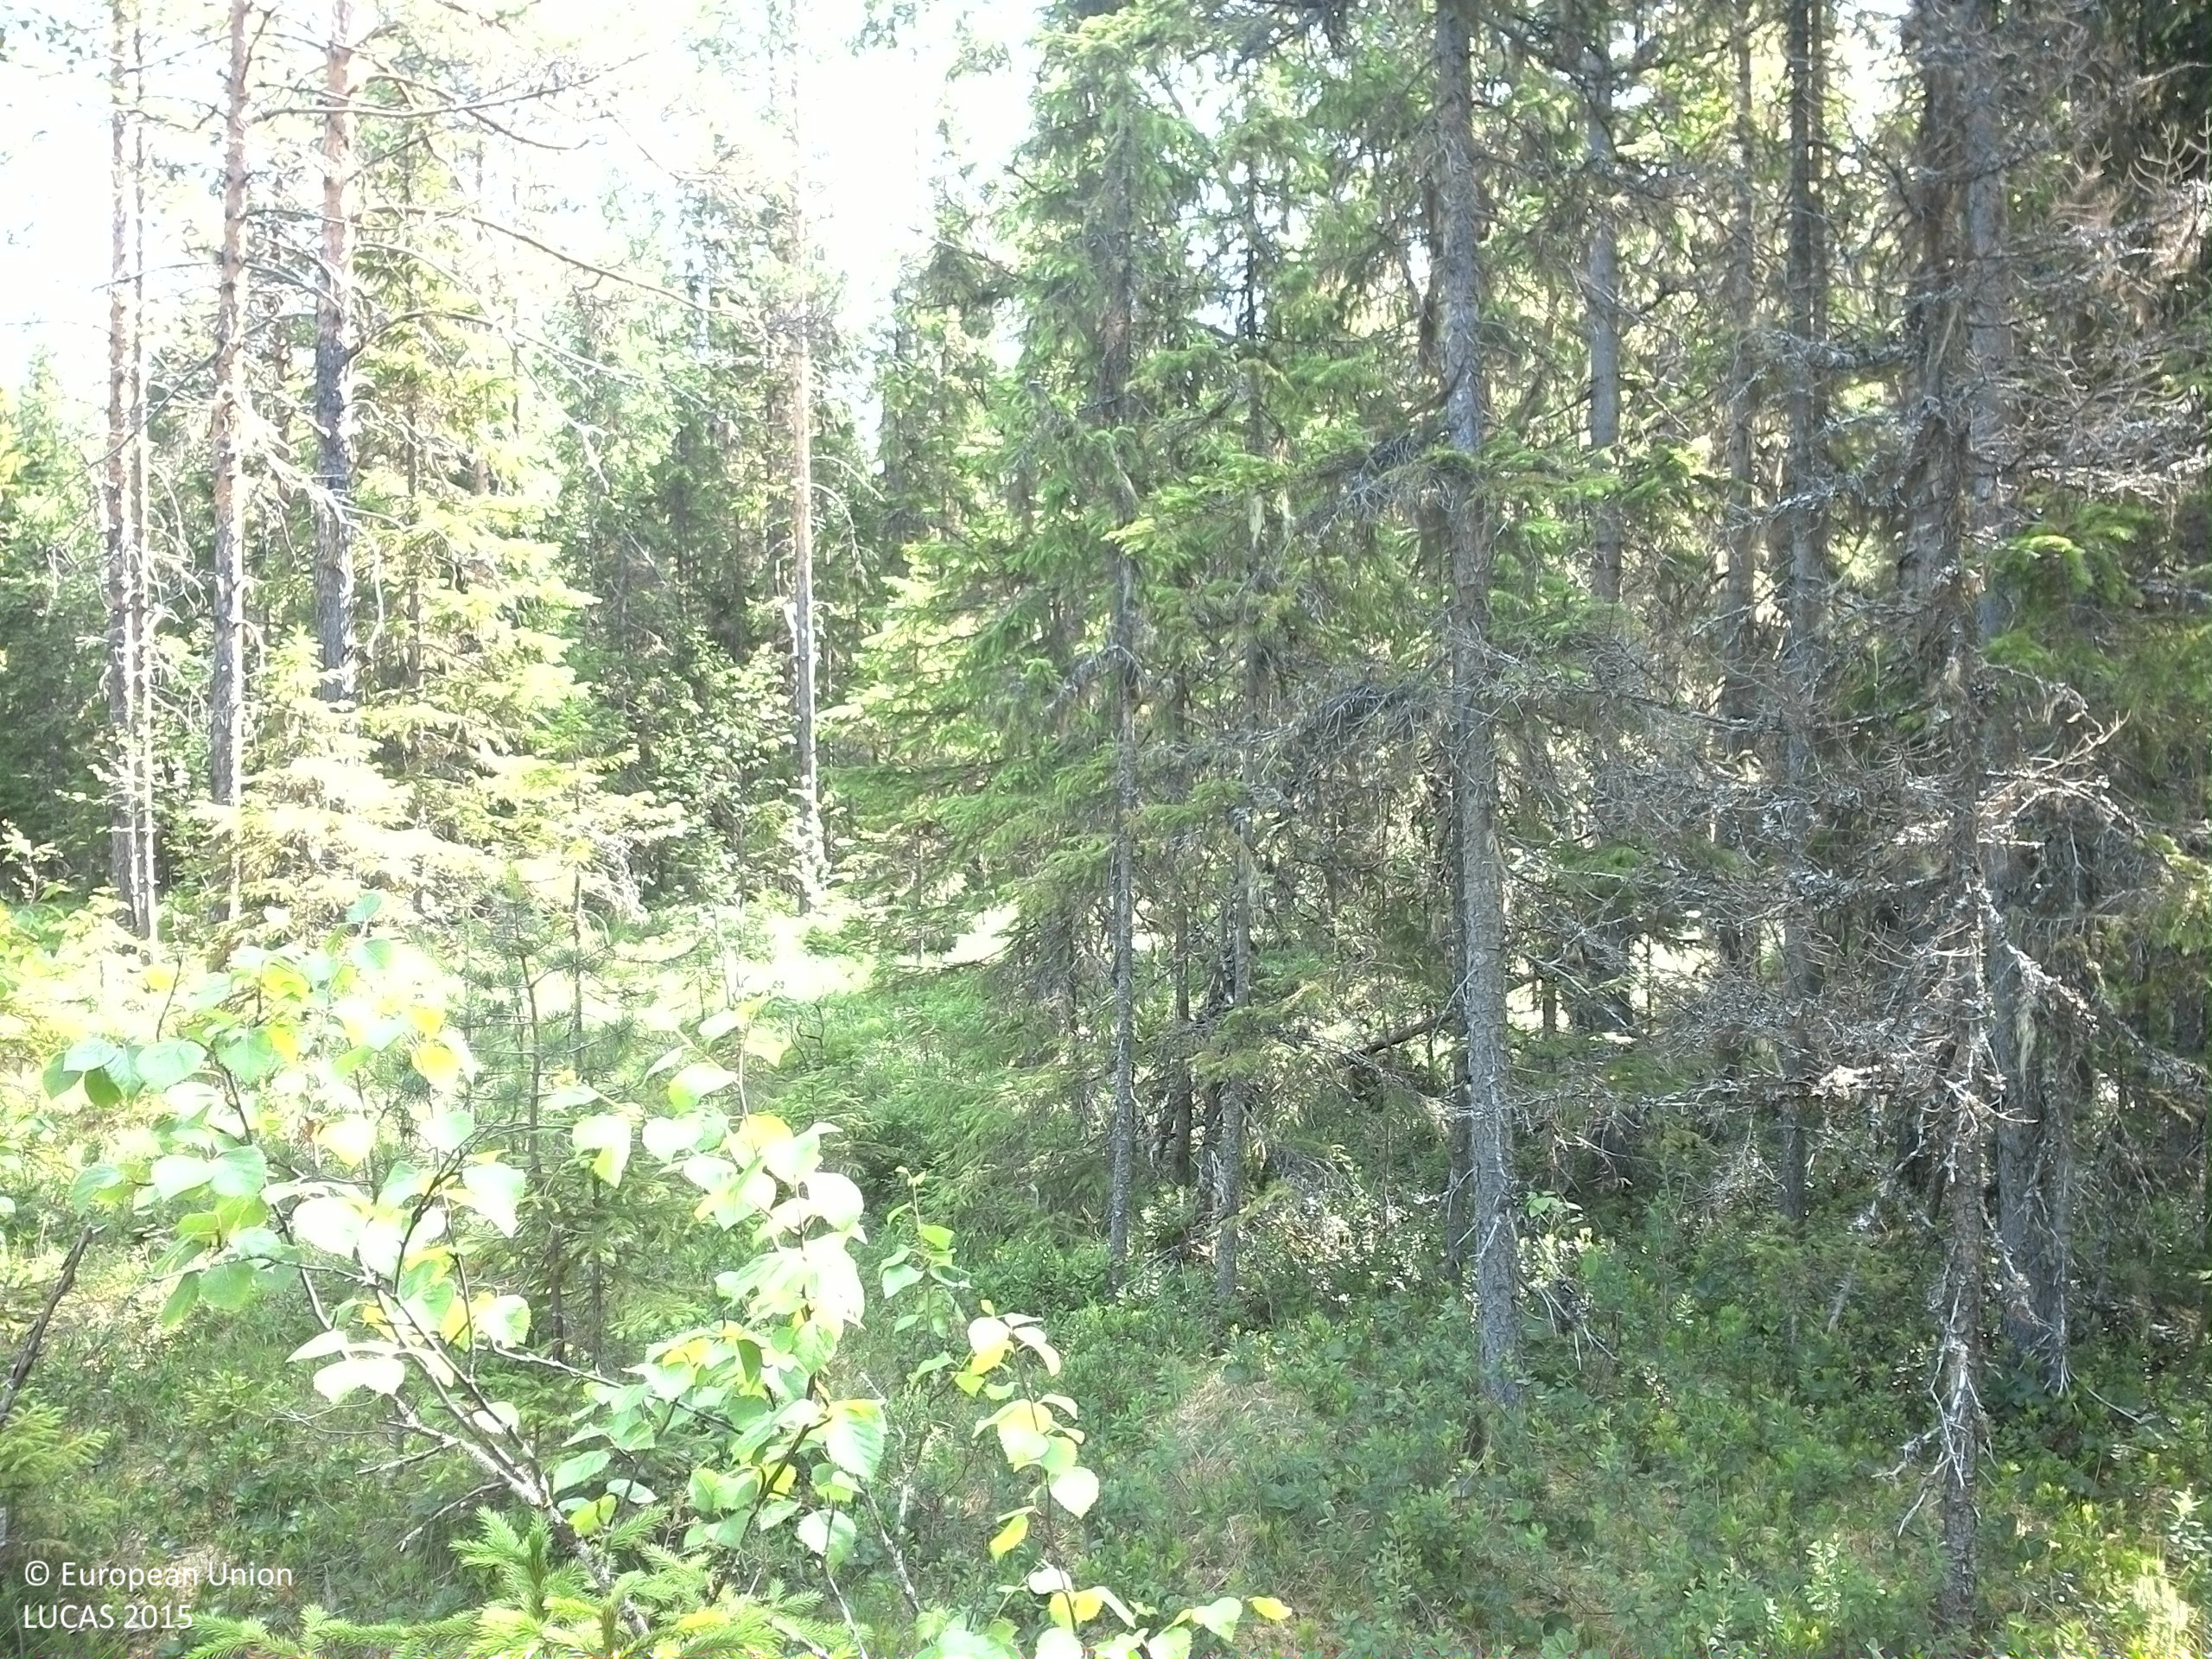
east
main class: Woodland
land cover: Spruce dominated coniferous woodland
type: boreal forest
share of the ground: 25 - 50 %
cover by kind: coniferous forest trees 35 %, lichens and mosses 30 %, shrubs 20 %, broadleaved forest trees 10 %, herbaceous plants 5 %
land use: Forestry
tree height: > 5 m
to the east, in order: Spruce dominated coniferous woodland; Rivers and streams; Spruce dominated coniferous woodland; Broadleaved woodland; Pine dominated coniferous woodland; Spruce dominated mixed woodland
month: July
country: SE
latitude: 63.4989
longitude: 17.7882
